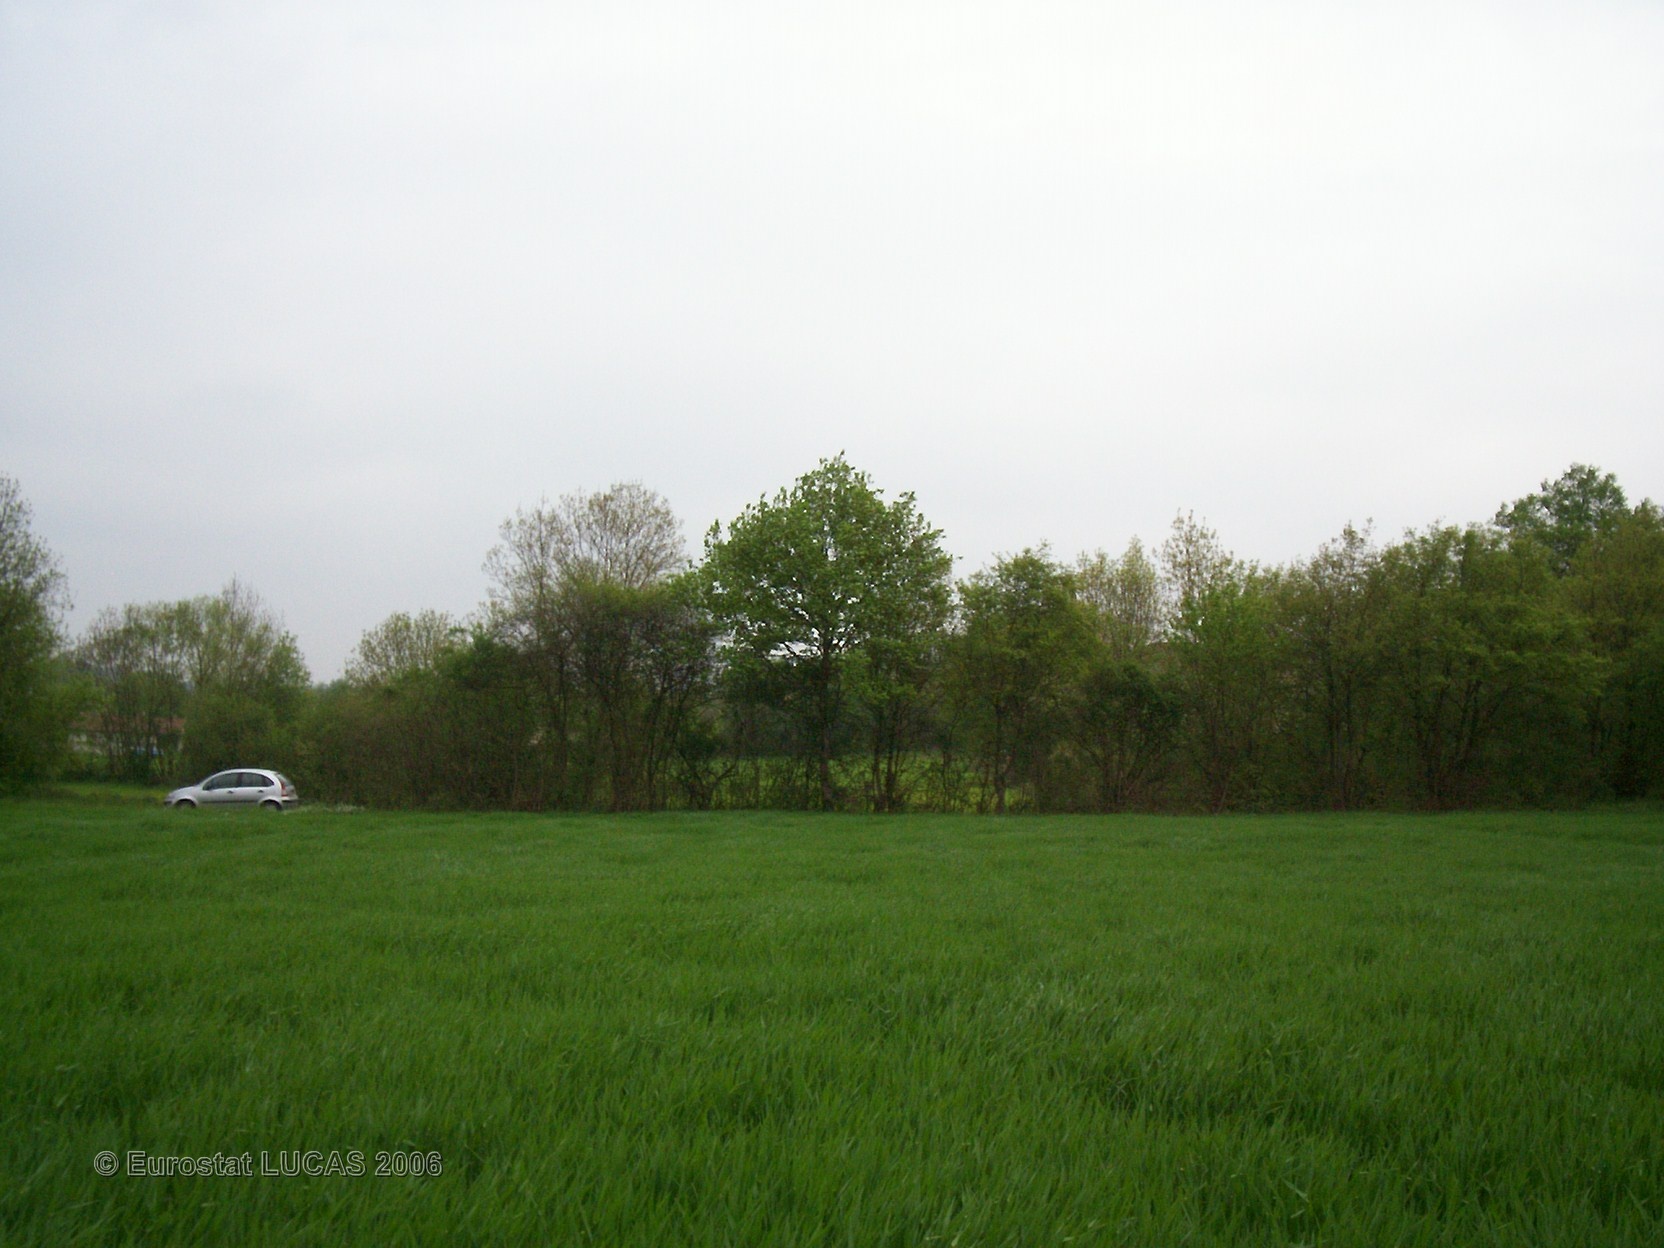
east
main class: Cropland
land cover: Barley
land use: Agriculture (excluding fallow land and kitchen gardens)
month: April
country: FR
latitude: 46.0979
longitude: 4.7898
